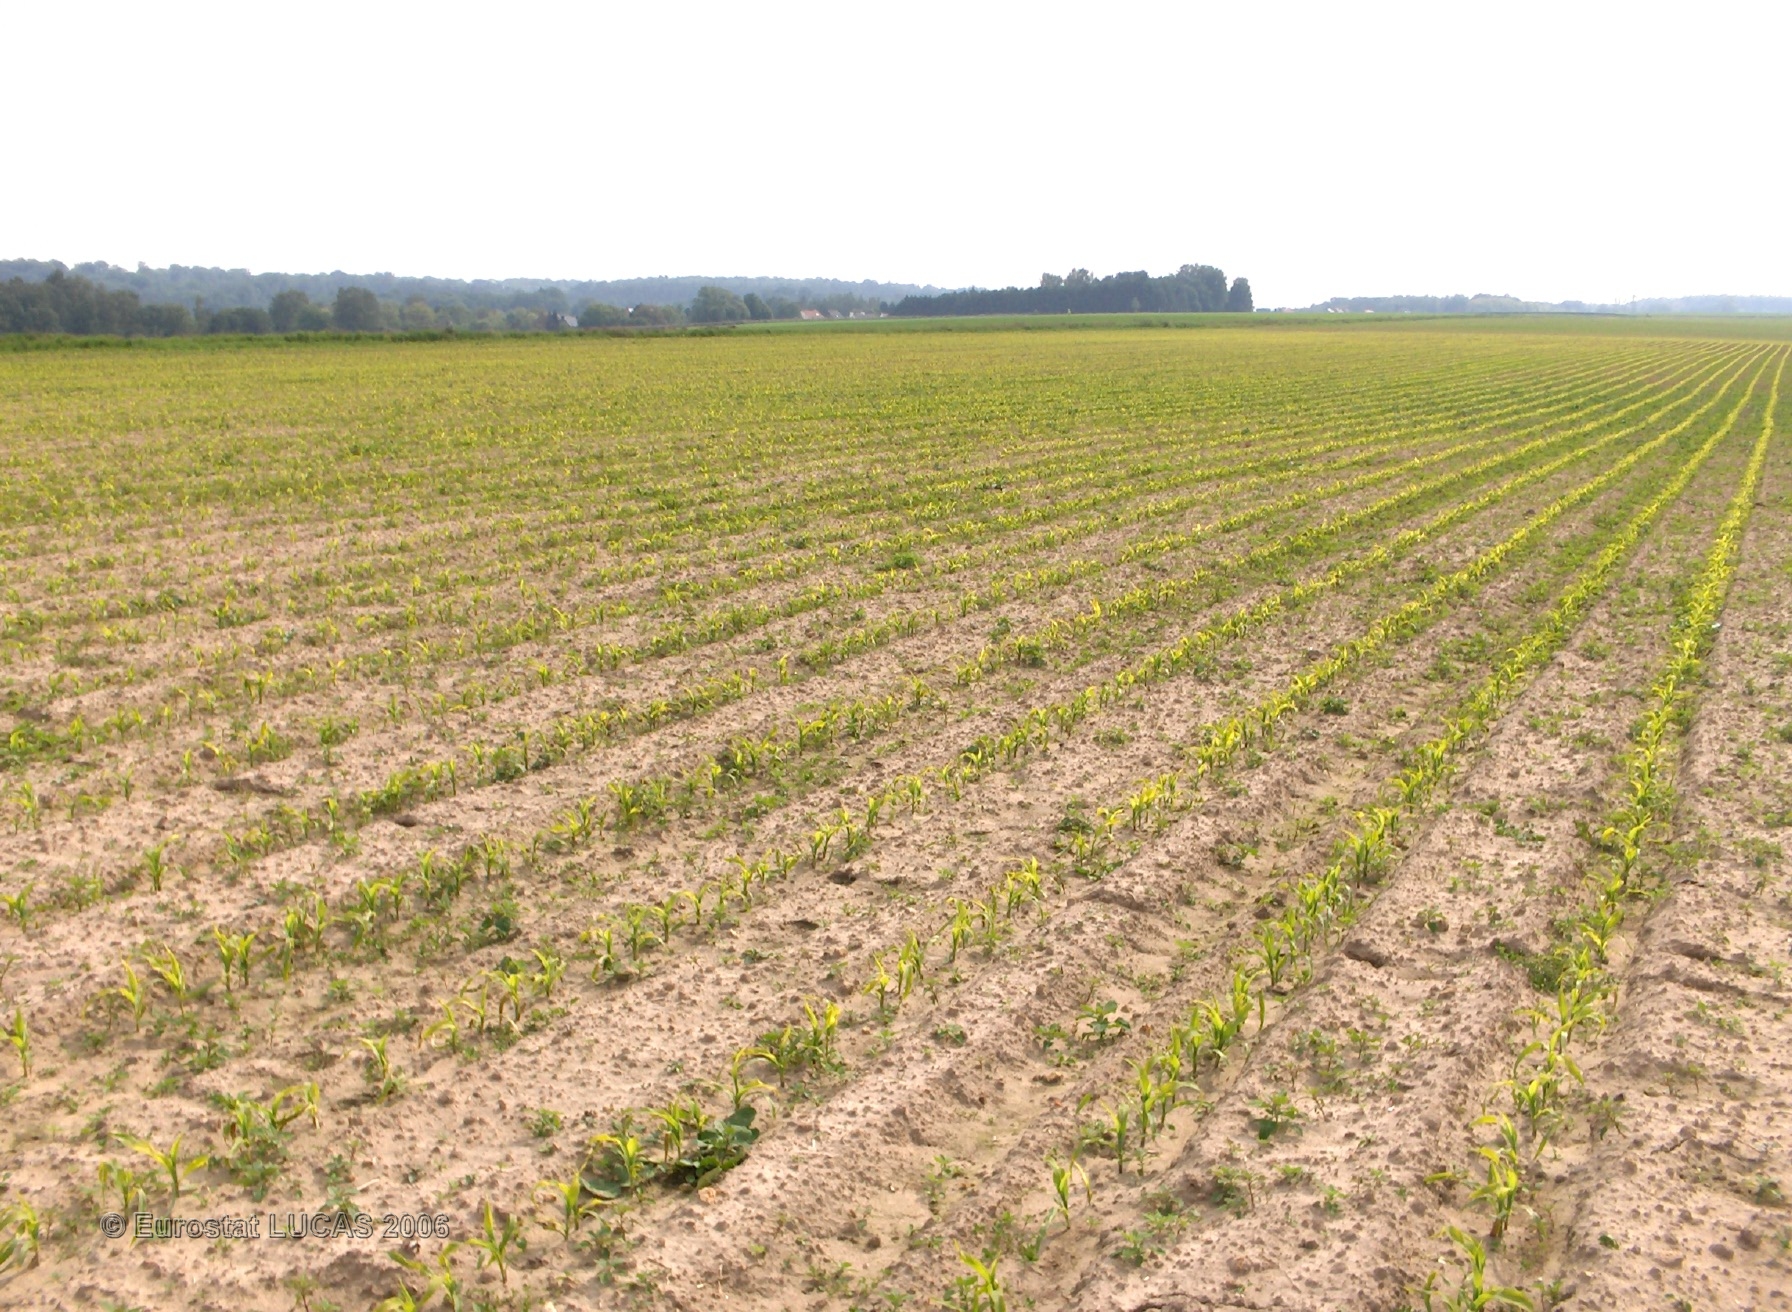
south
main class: Cropland
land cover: Maize
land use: Agriculture (excluding fallow land and kitchen gardens)
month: May
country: BE
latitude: 50.6115
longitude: 4.5269
